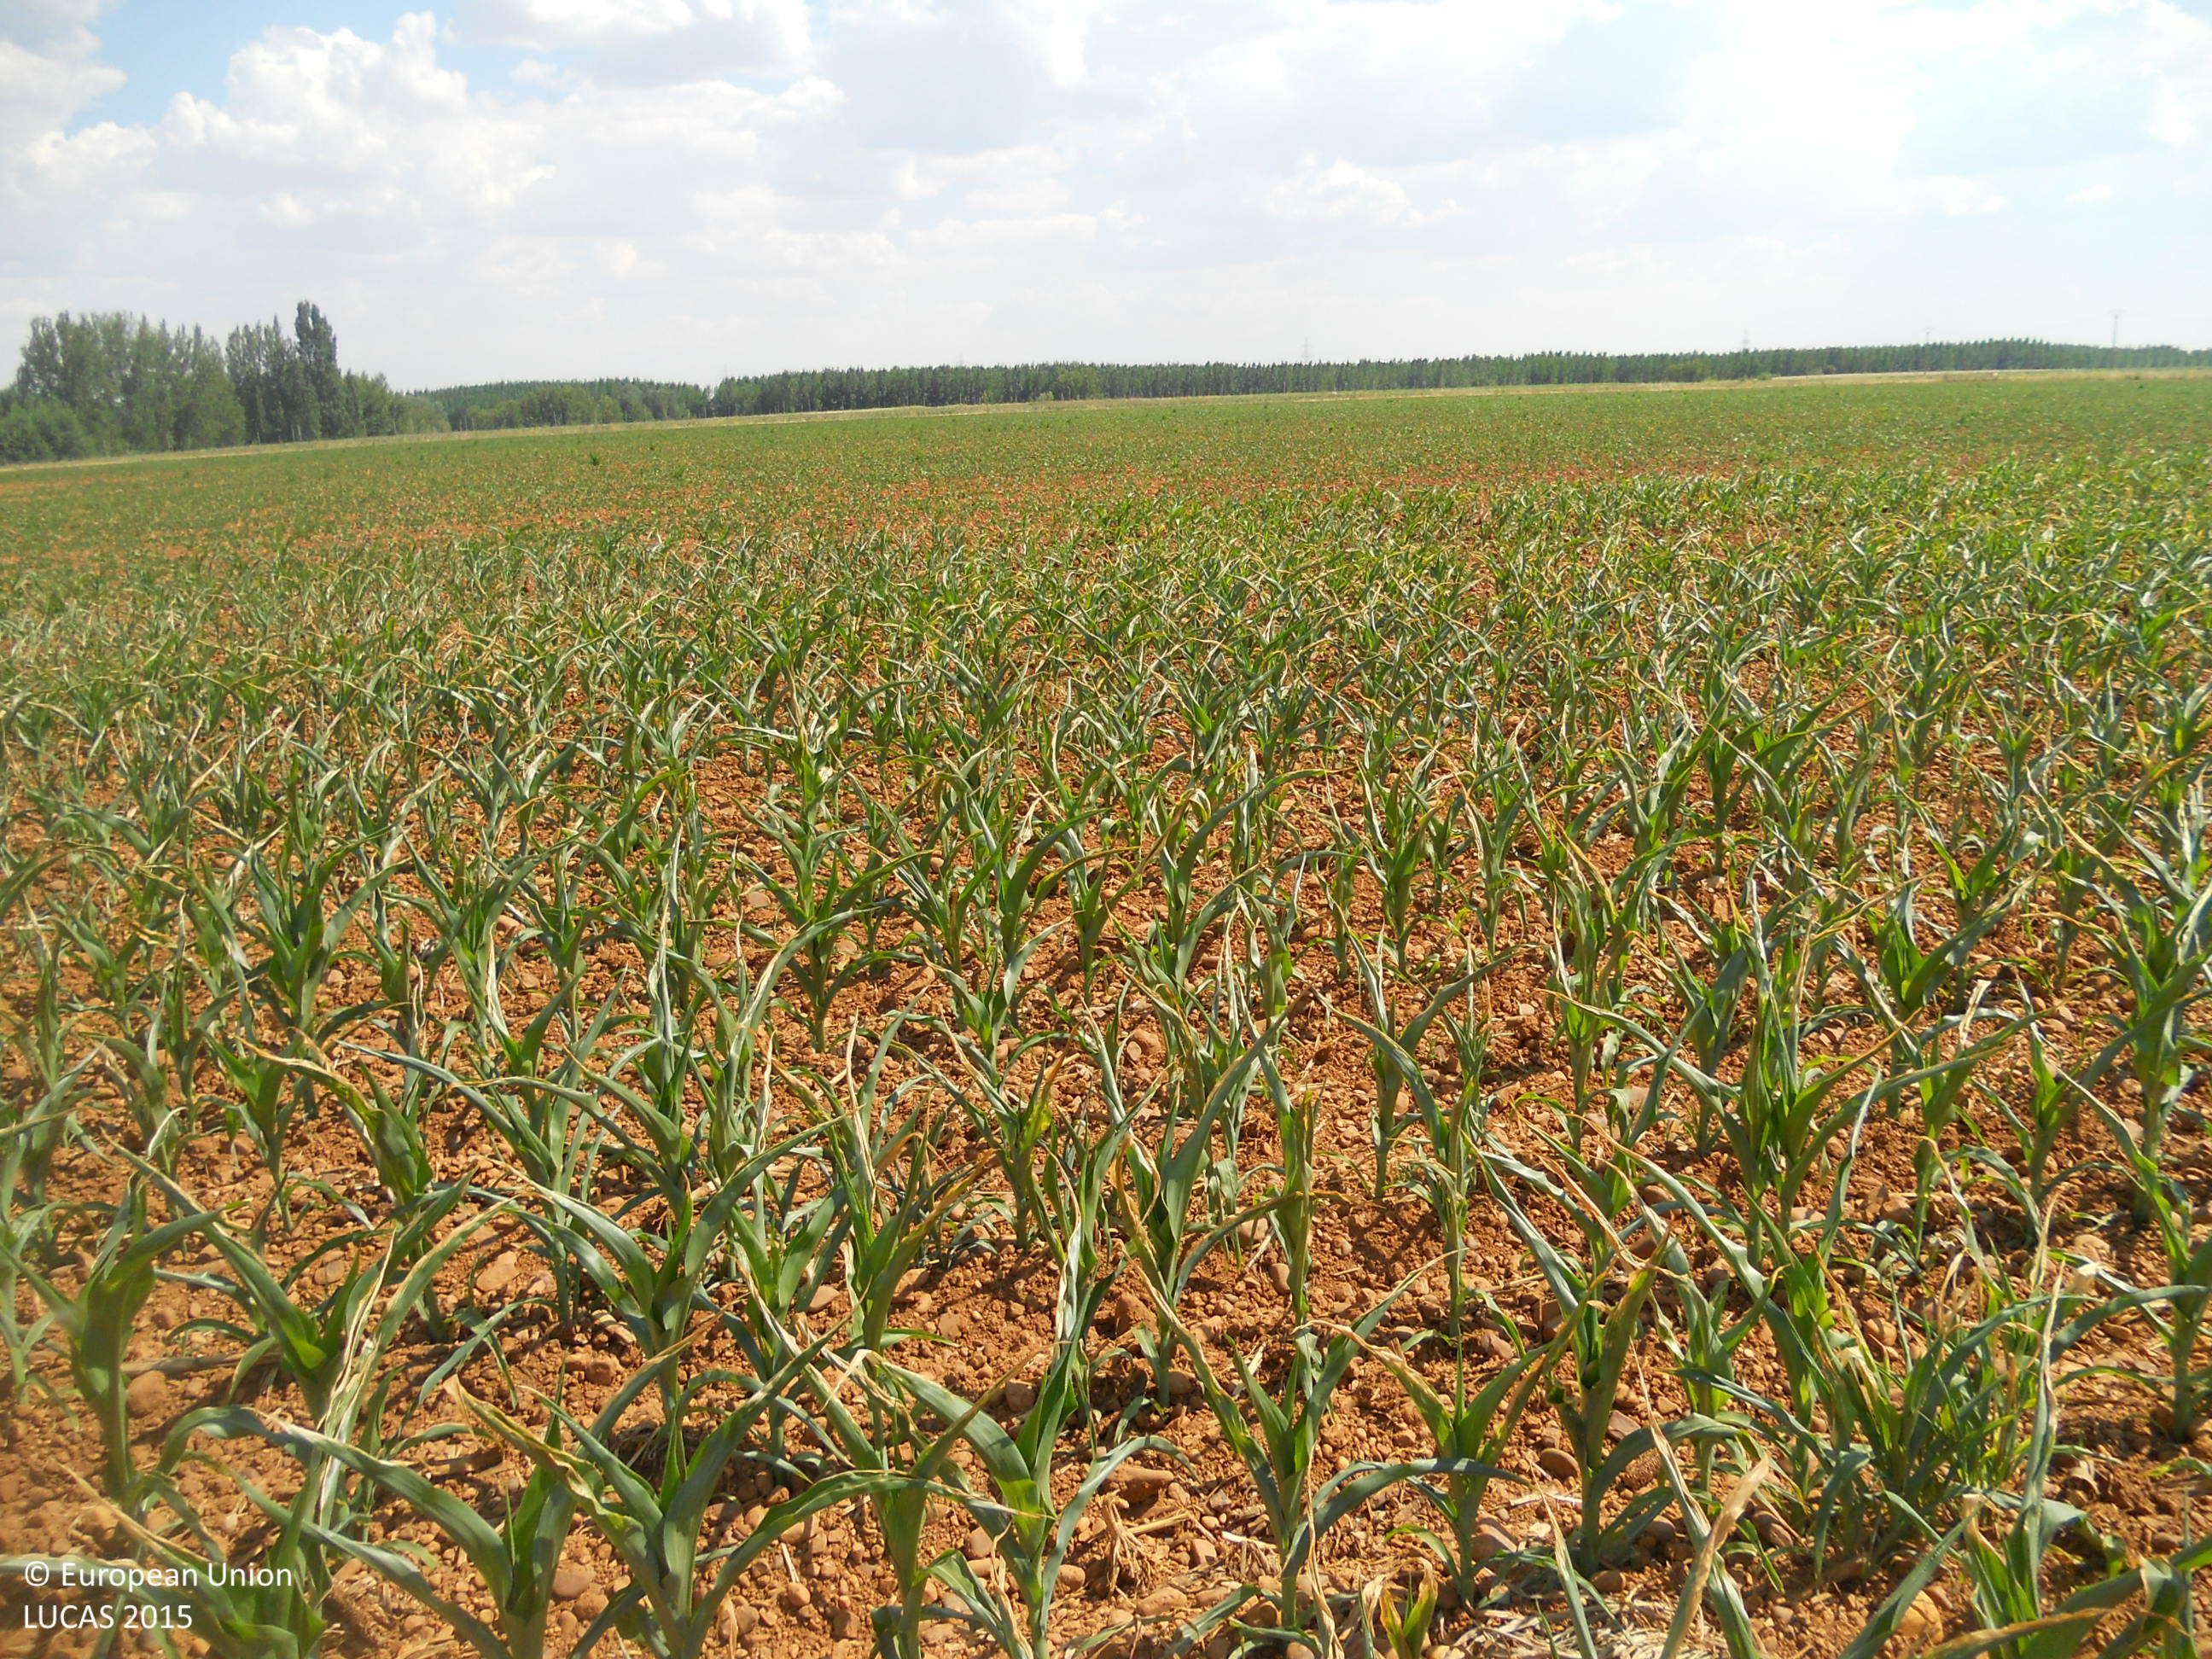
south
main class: Cropland
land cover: Maize
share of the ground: > 75 %
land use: Agriculture (excluding fallow land and kitchen gardens)
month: June
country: ES
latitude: 42.1989
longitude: -5.6560
